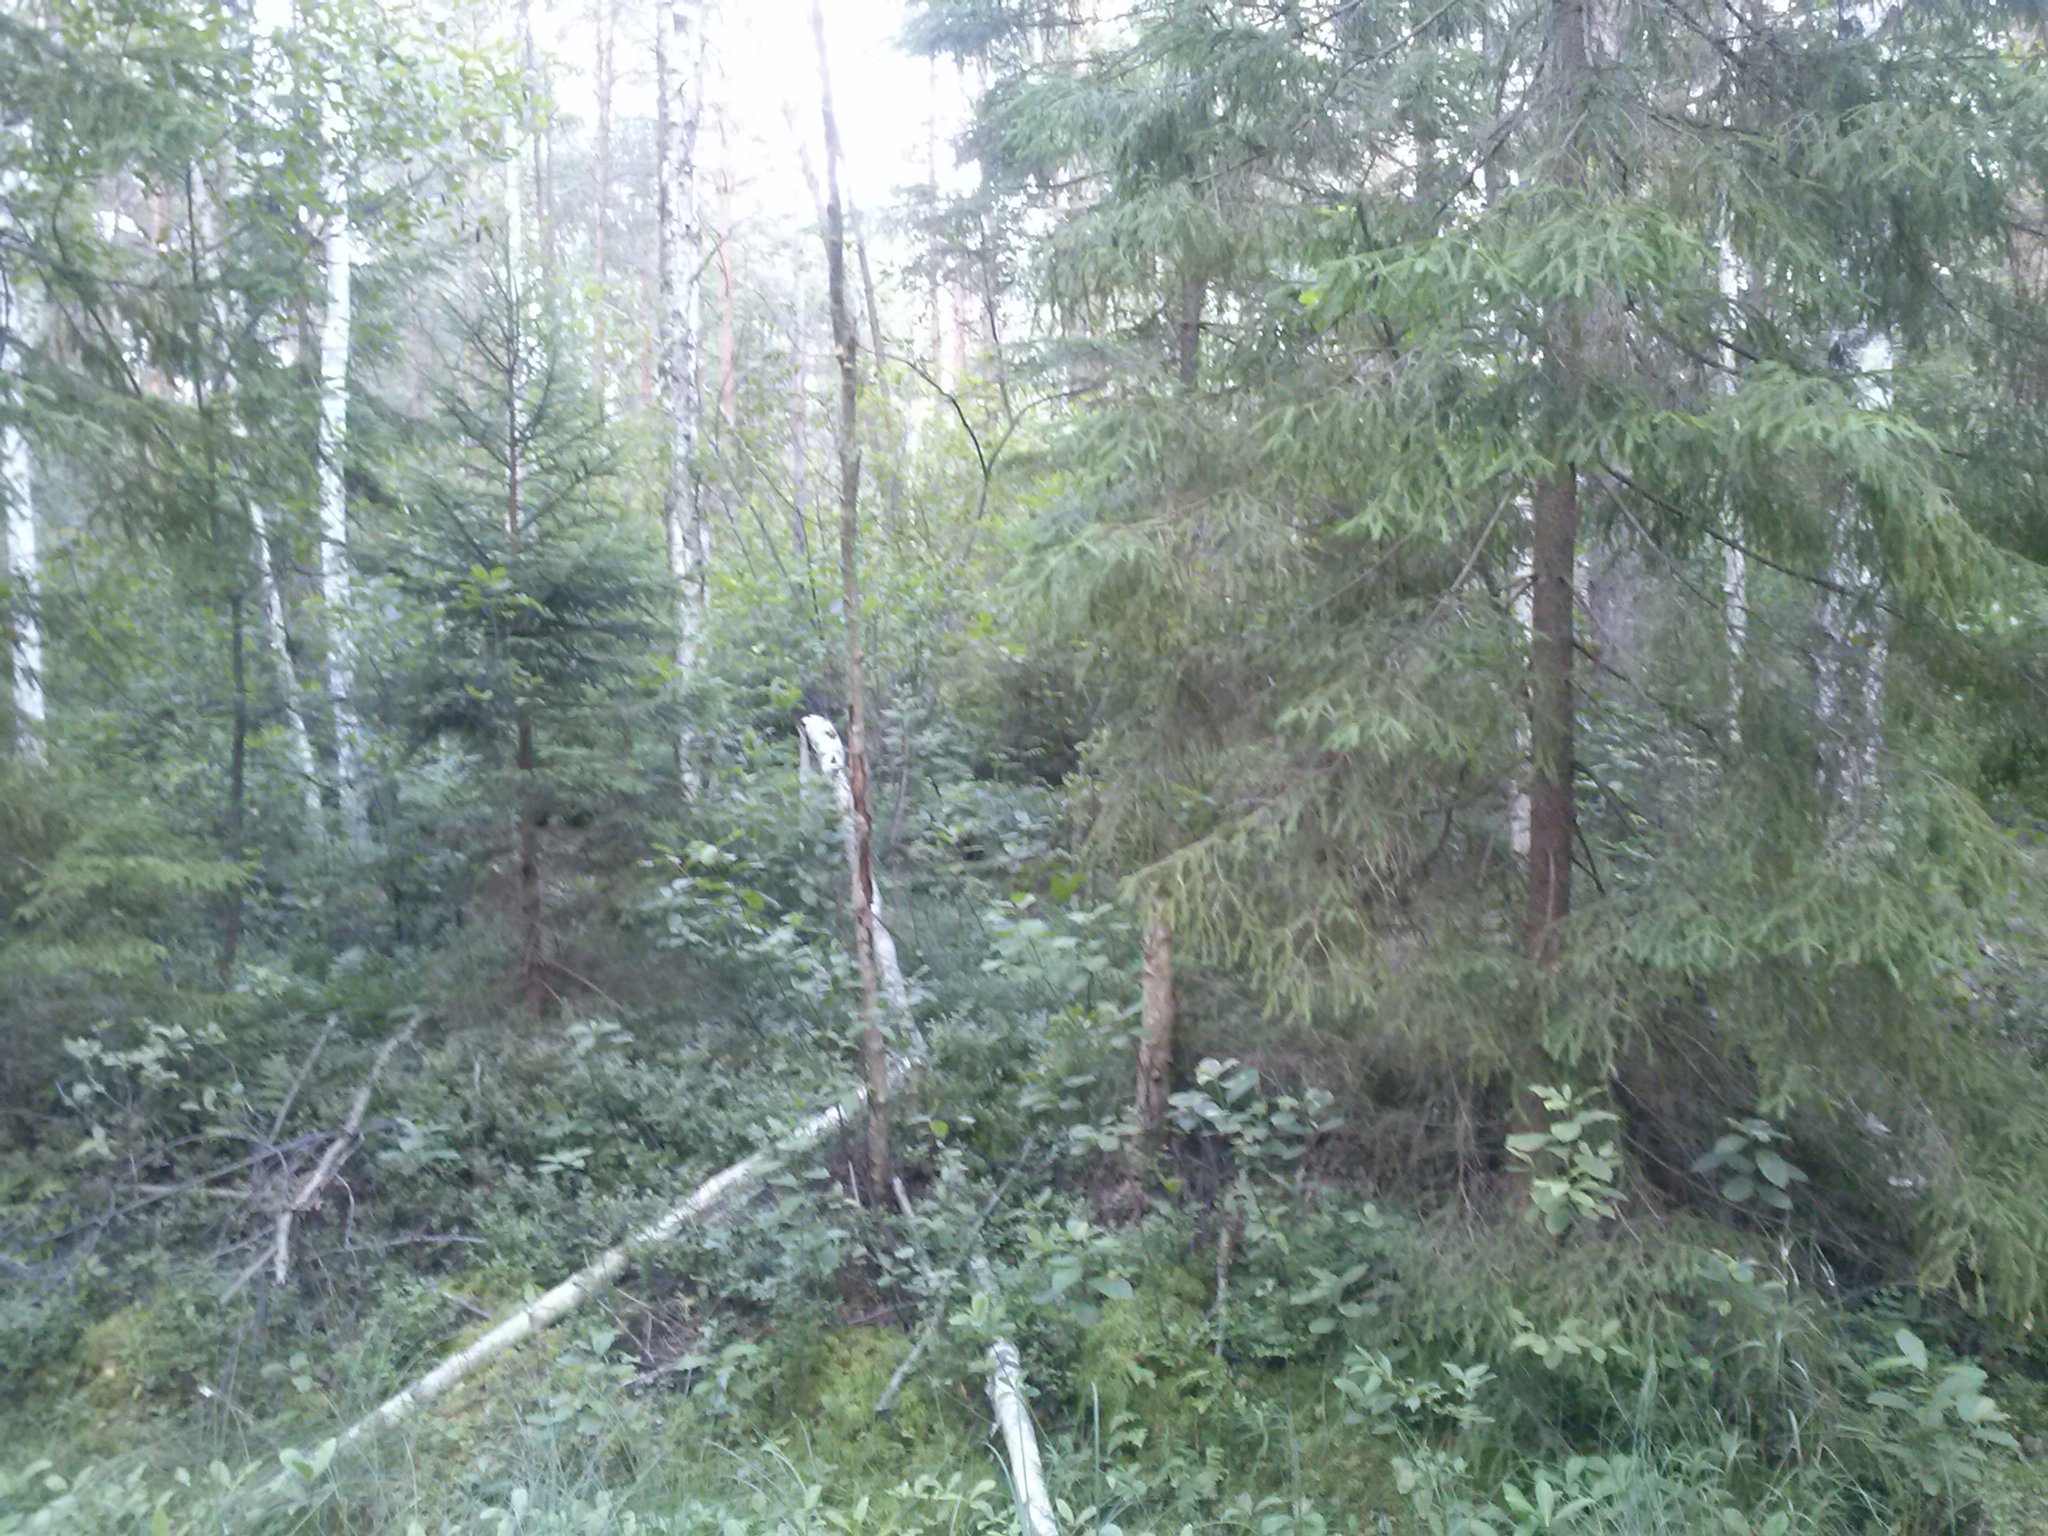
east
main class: Woodland
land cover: Spruce dominated mixed woodland
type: hemiboreal forest and nemoral coniferous forest and mixed broadleaved-coniferous forest
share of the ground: > 75 %
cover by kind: coniferous forest trees 50 %, broadleaved forest trees 30 %, herbaceous plants 20 %
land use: Forestry
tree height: > 5 m
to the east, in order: Spruce dominated mixed woodland; Pine dominated mixed woodland; Pine dominated coniferous woodland
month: July
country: LV
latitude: 56.8126
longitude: 27.7967
